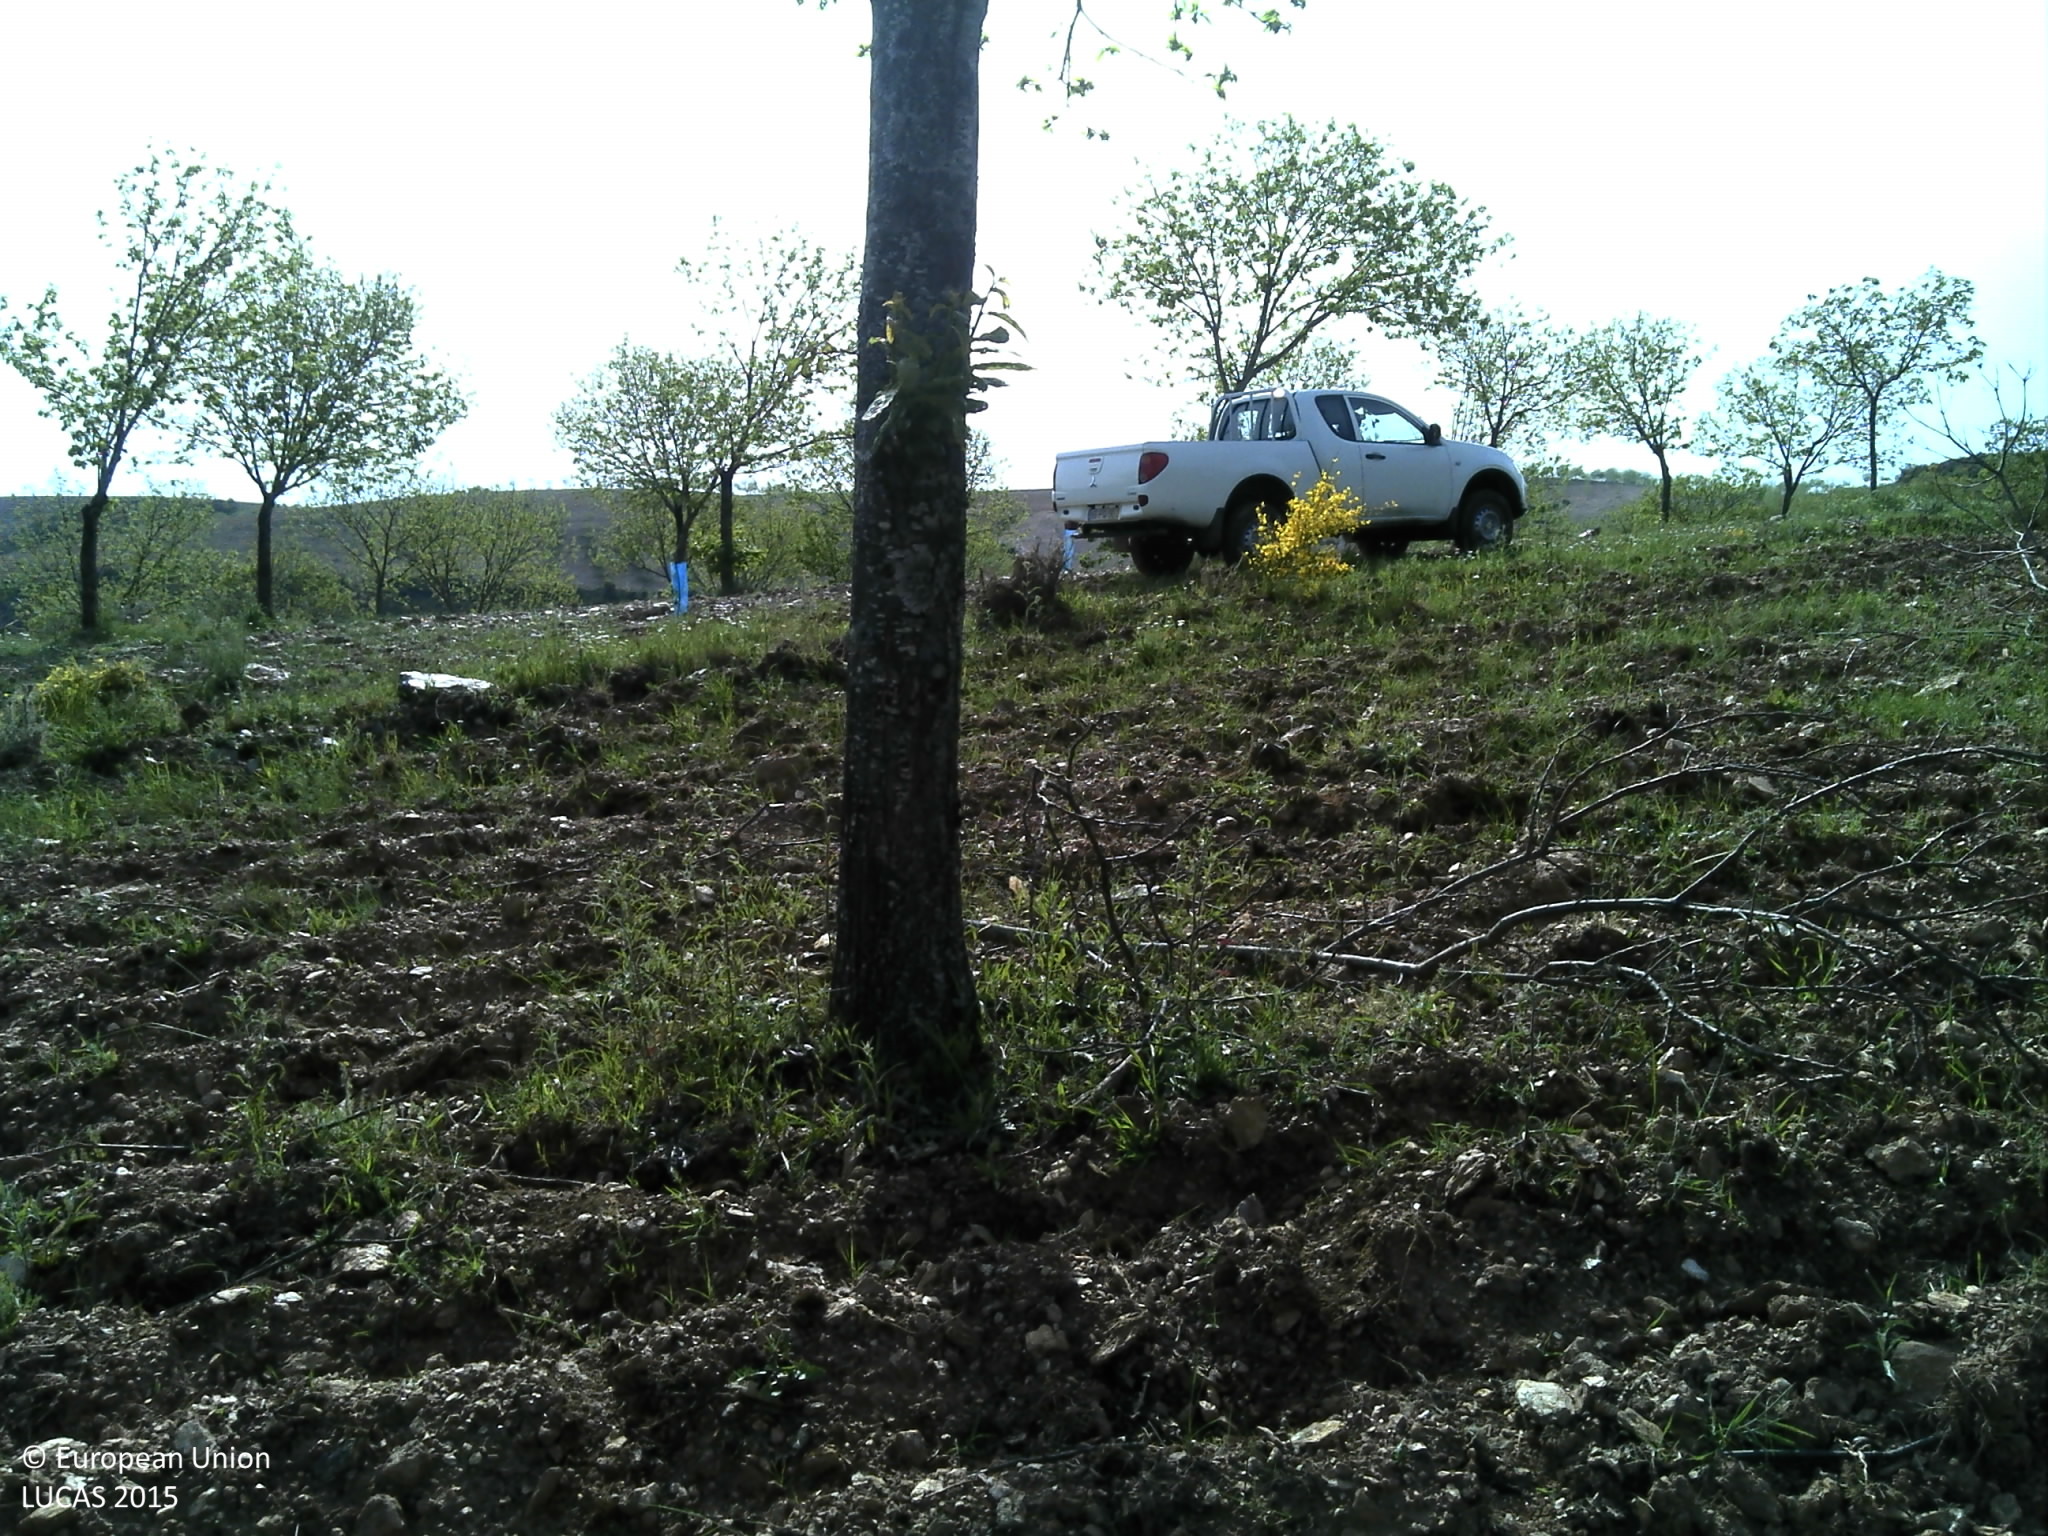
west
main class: Cropland
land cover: Nuts trees
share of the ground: 10 - 25 %
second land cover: Spontaneously vegetated surfaces
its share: 10 - 25 %
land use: Agriculture (excluding fallow land and kitchen gardens)
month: May
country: PT
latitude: 41.7096
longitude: -6.9542
